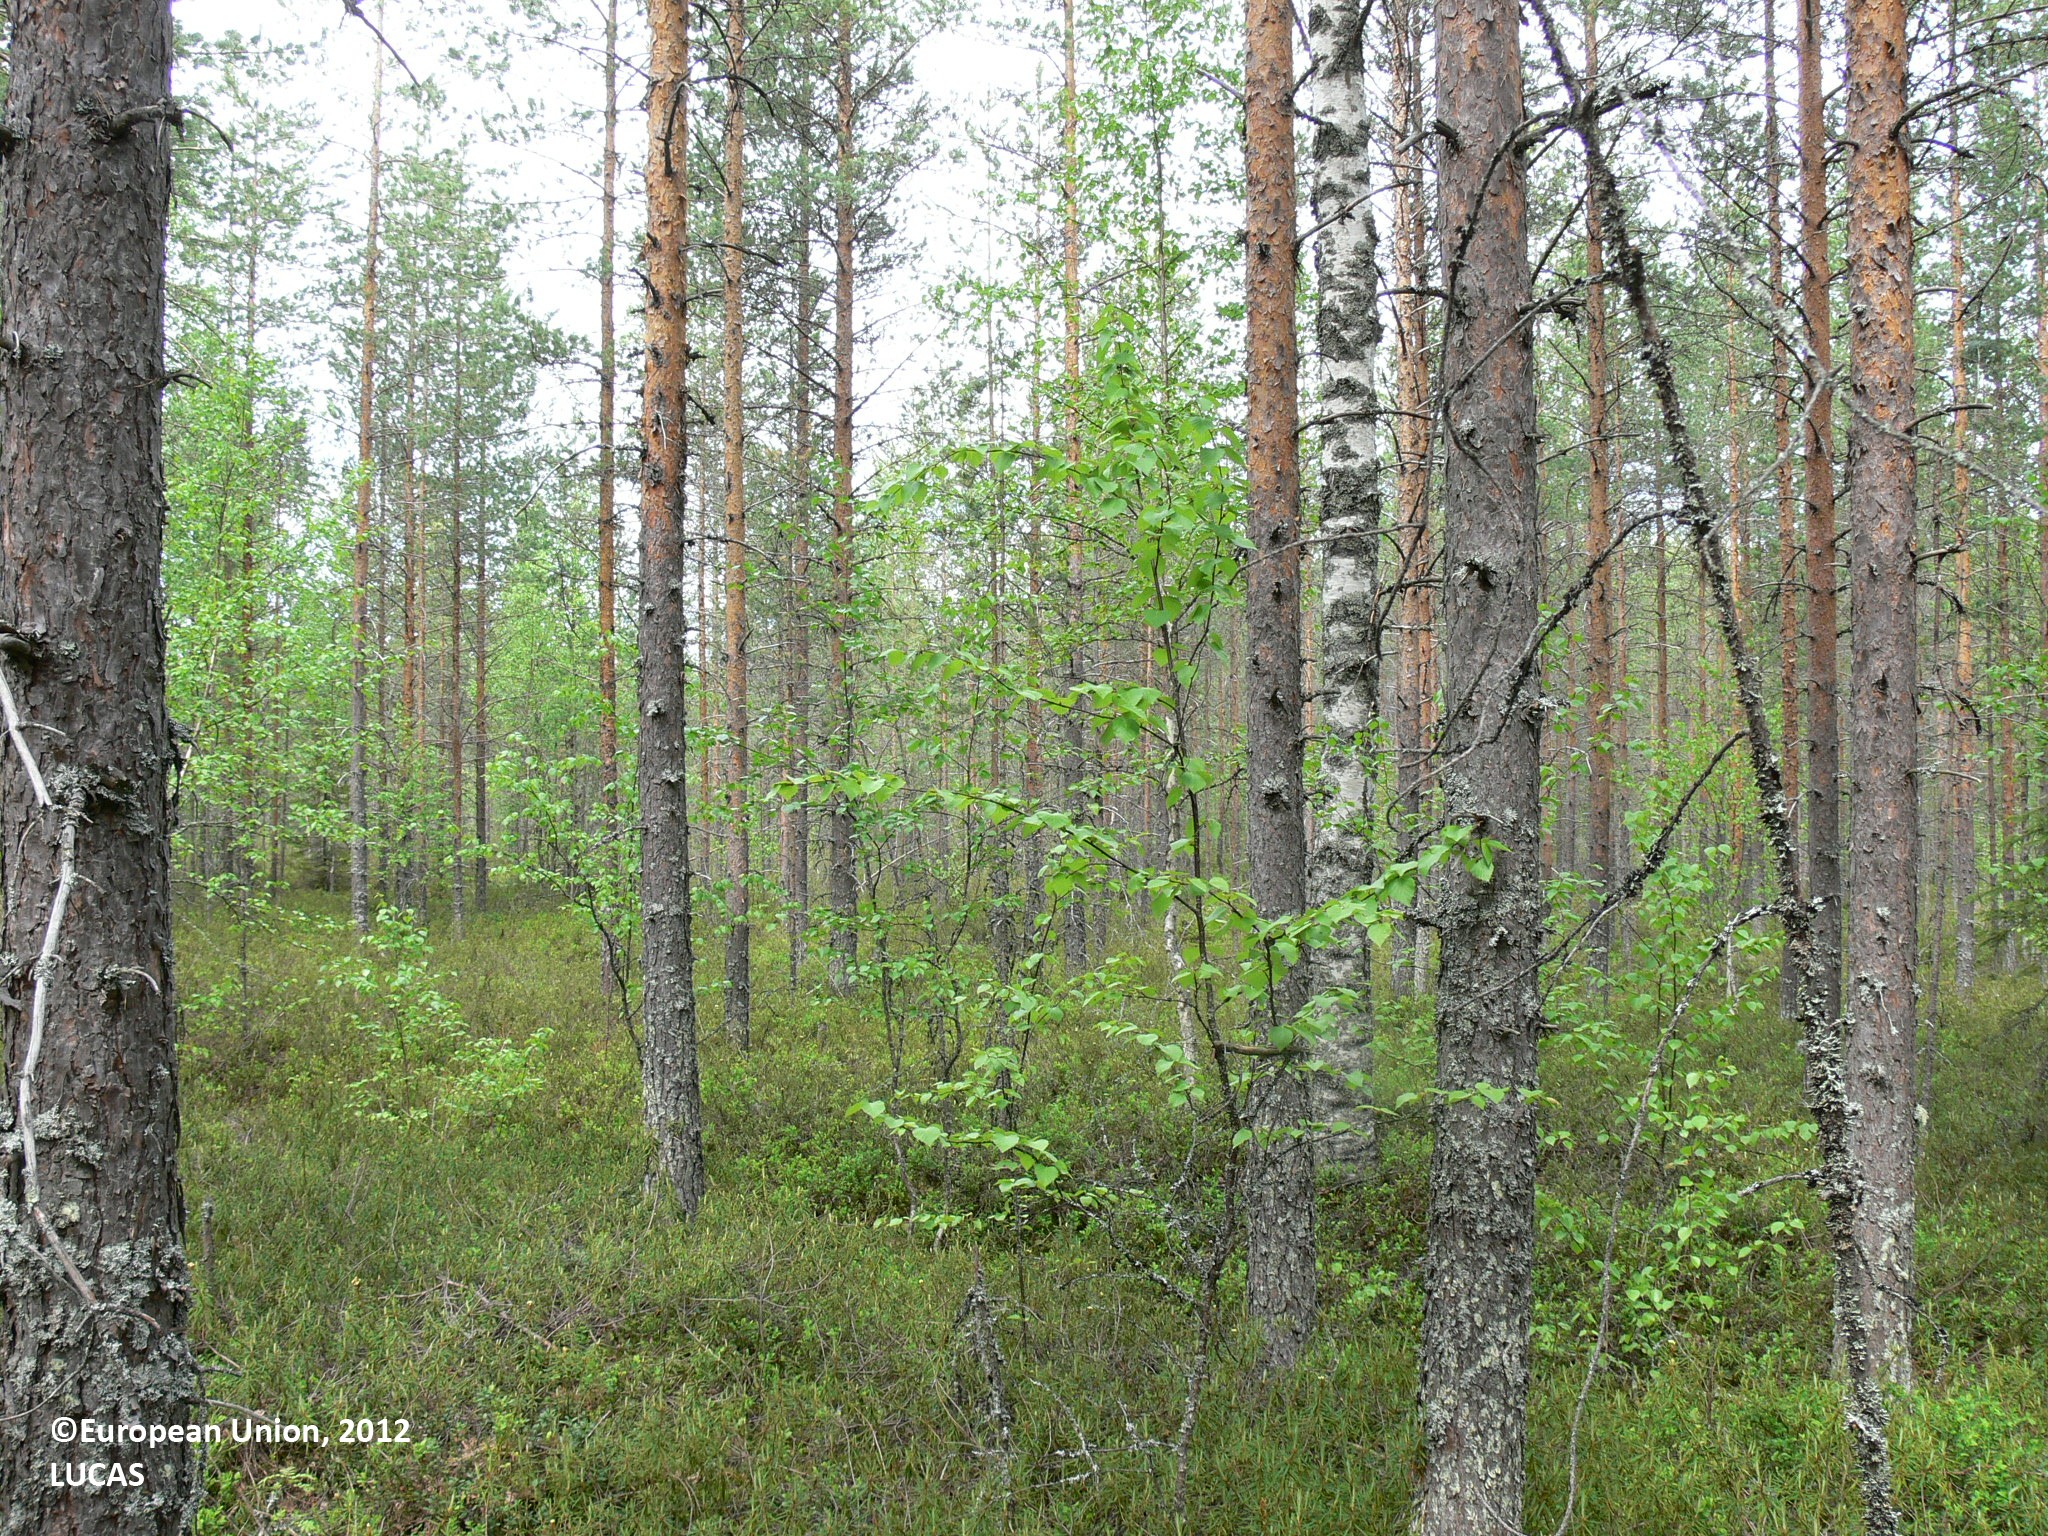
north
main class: Woodland
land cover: Pine dominated coniferous woodland
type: boreal forest
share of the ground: > 75 %
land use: Forestry
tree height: > 5 m
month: June
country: FI
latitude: 62.2713
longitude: 30.1716
